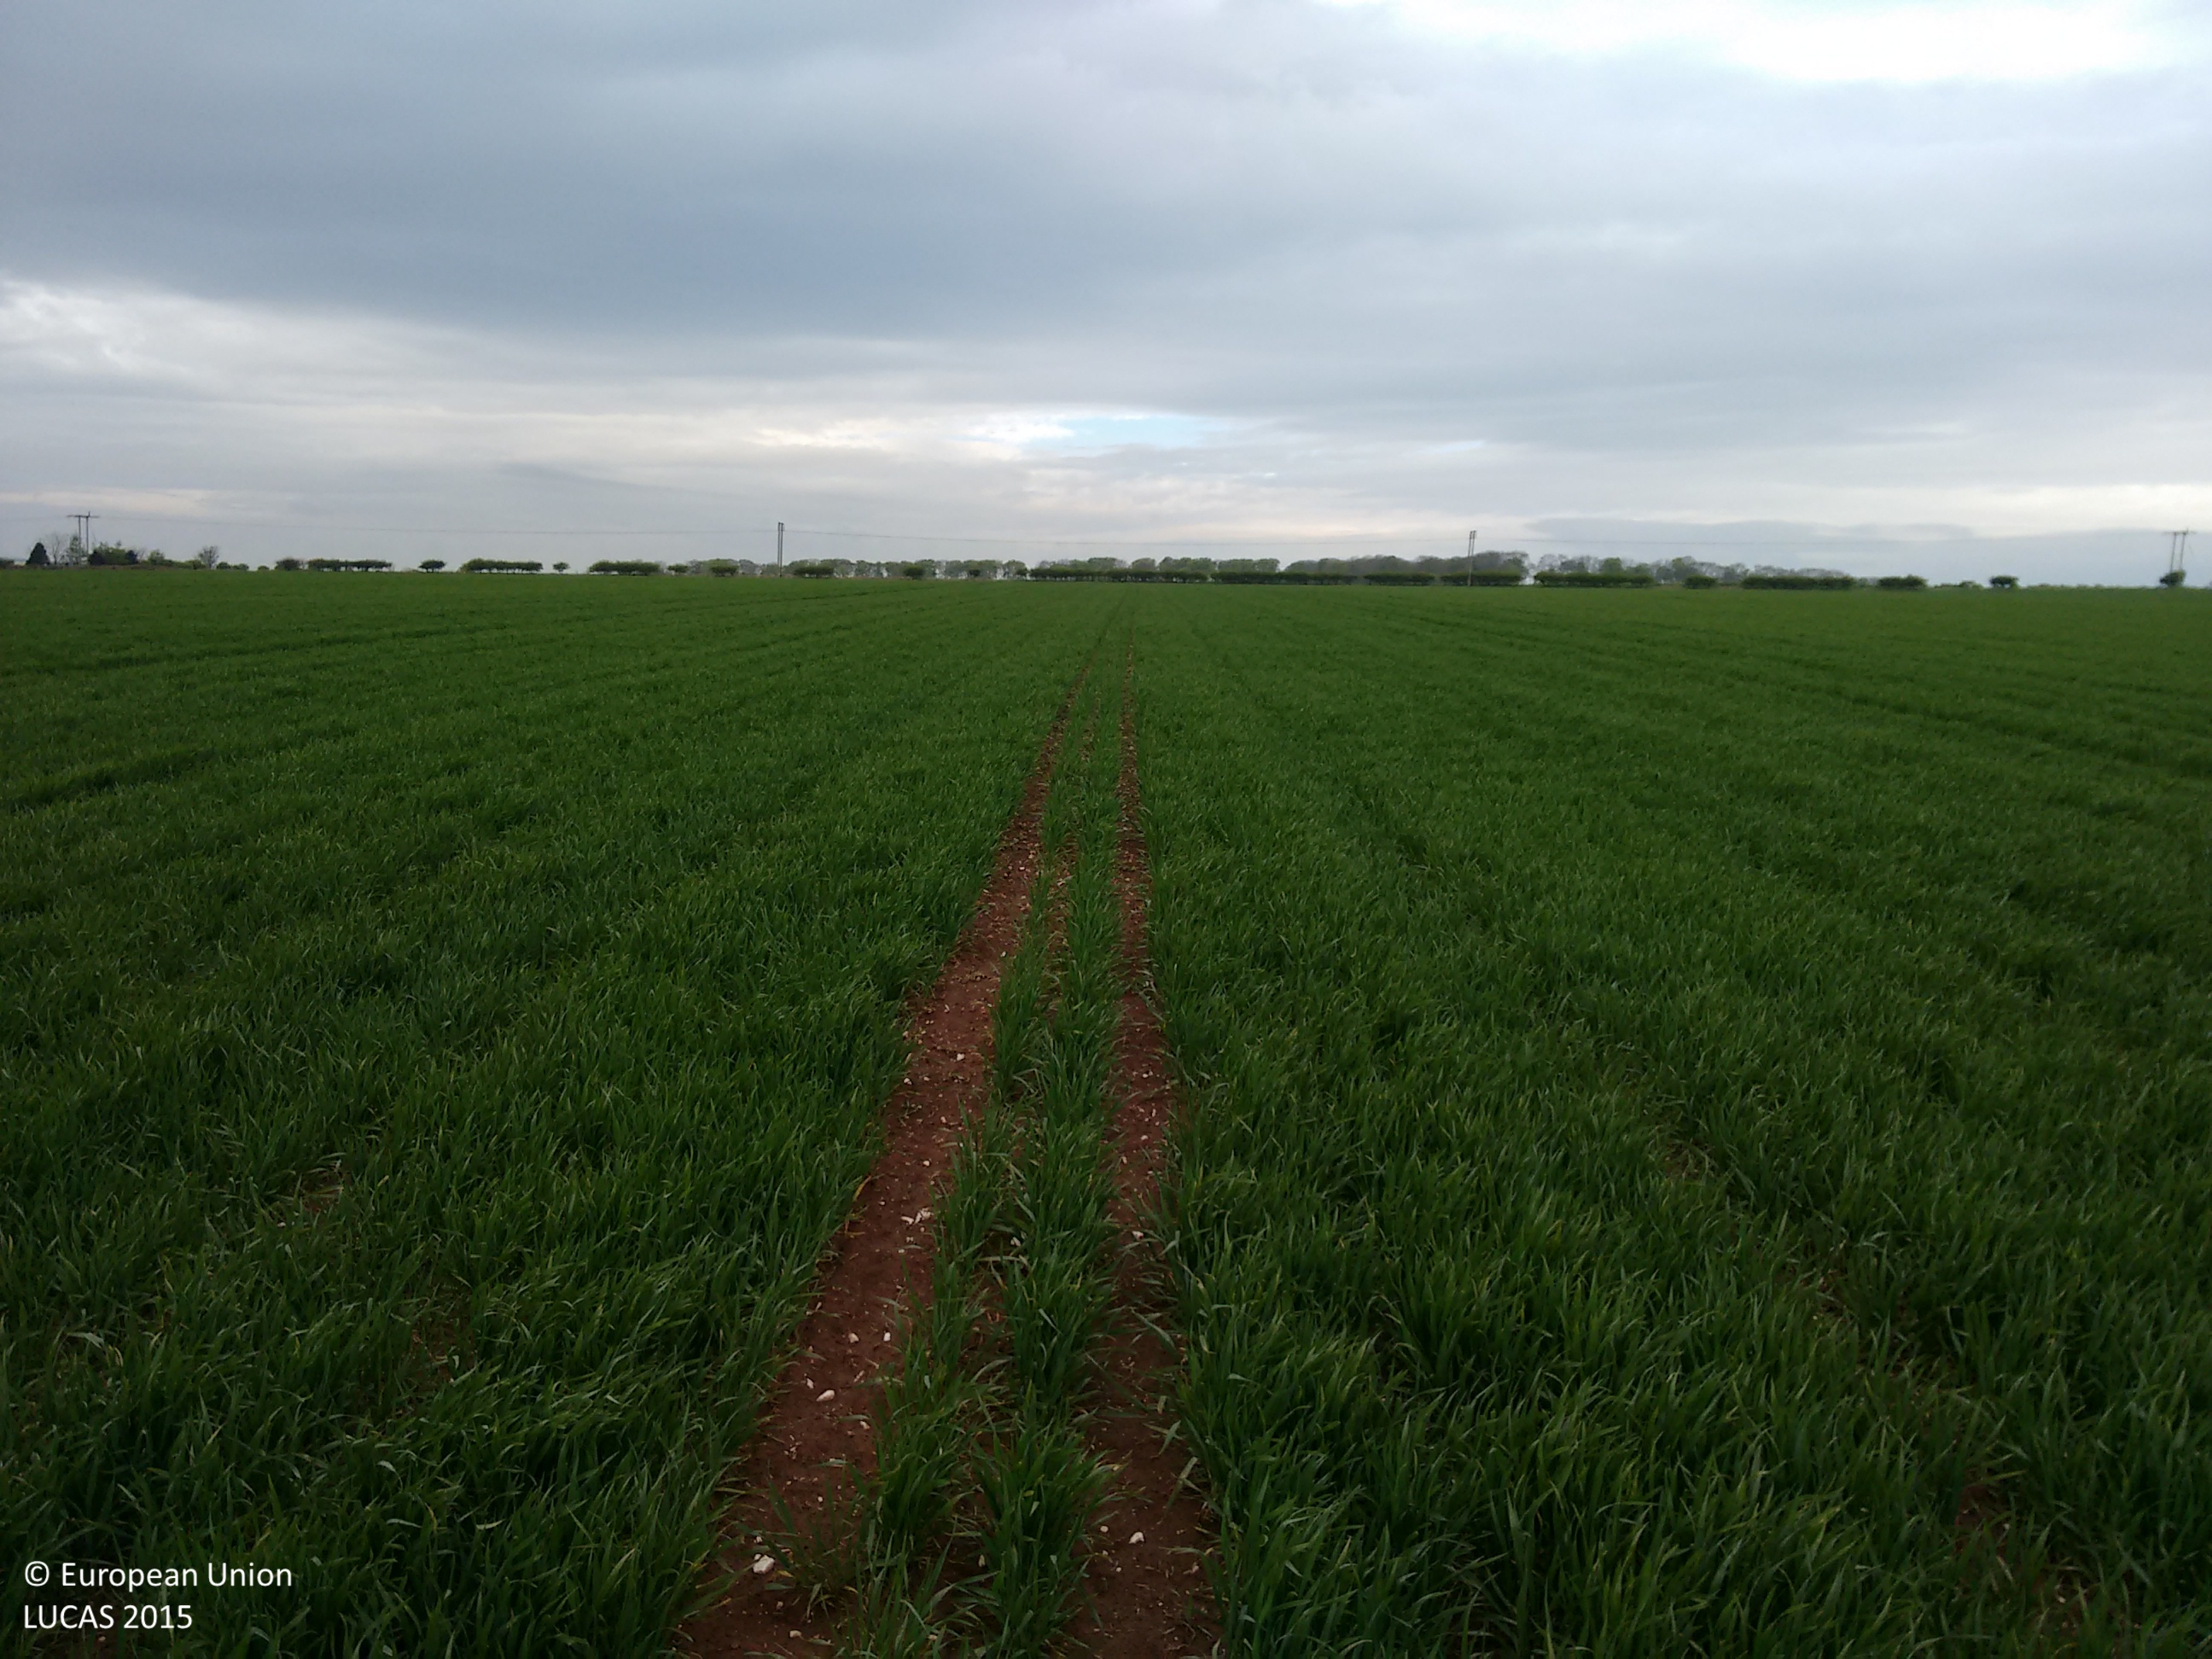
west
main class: Cropland
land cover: Common wheat
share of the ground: > 75 %
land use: Agriculture (excluding fallow land and kitchen gardens)
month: May
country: GB
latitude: 54.1523
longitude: -0.3701
